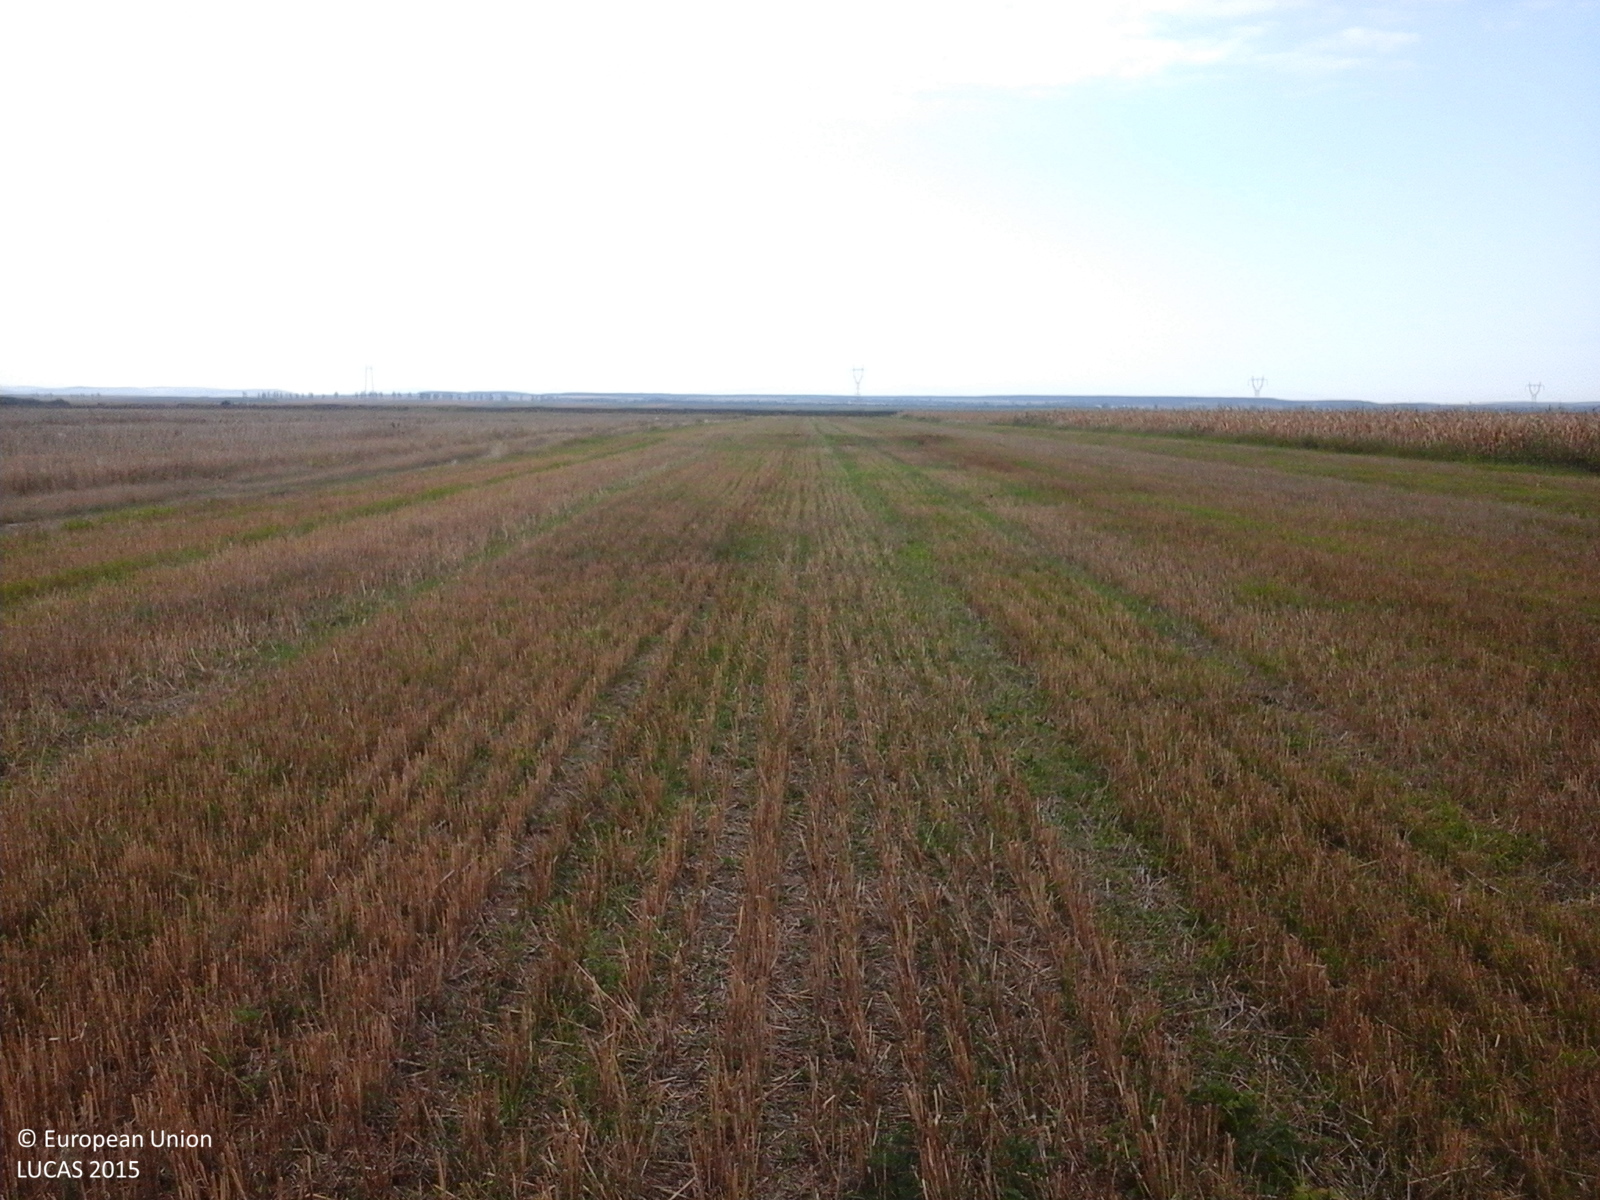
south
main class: Cropland
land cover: Common wheat
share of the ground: > 75 %
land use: Agriculture (excluding fallow land and kitchen gardens)
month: September
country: RO
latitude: 47.5523
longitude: 22.7516
